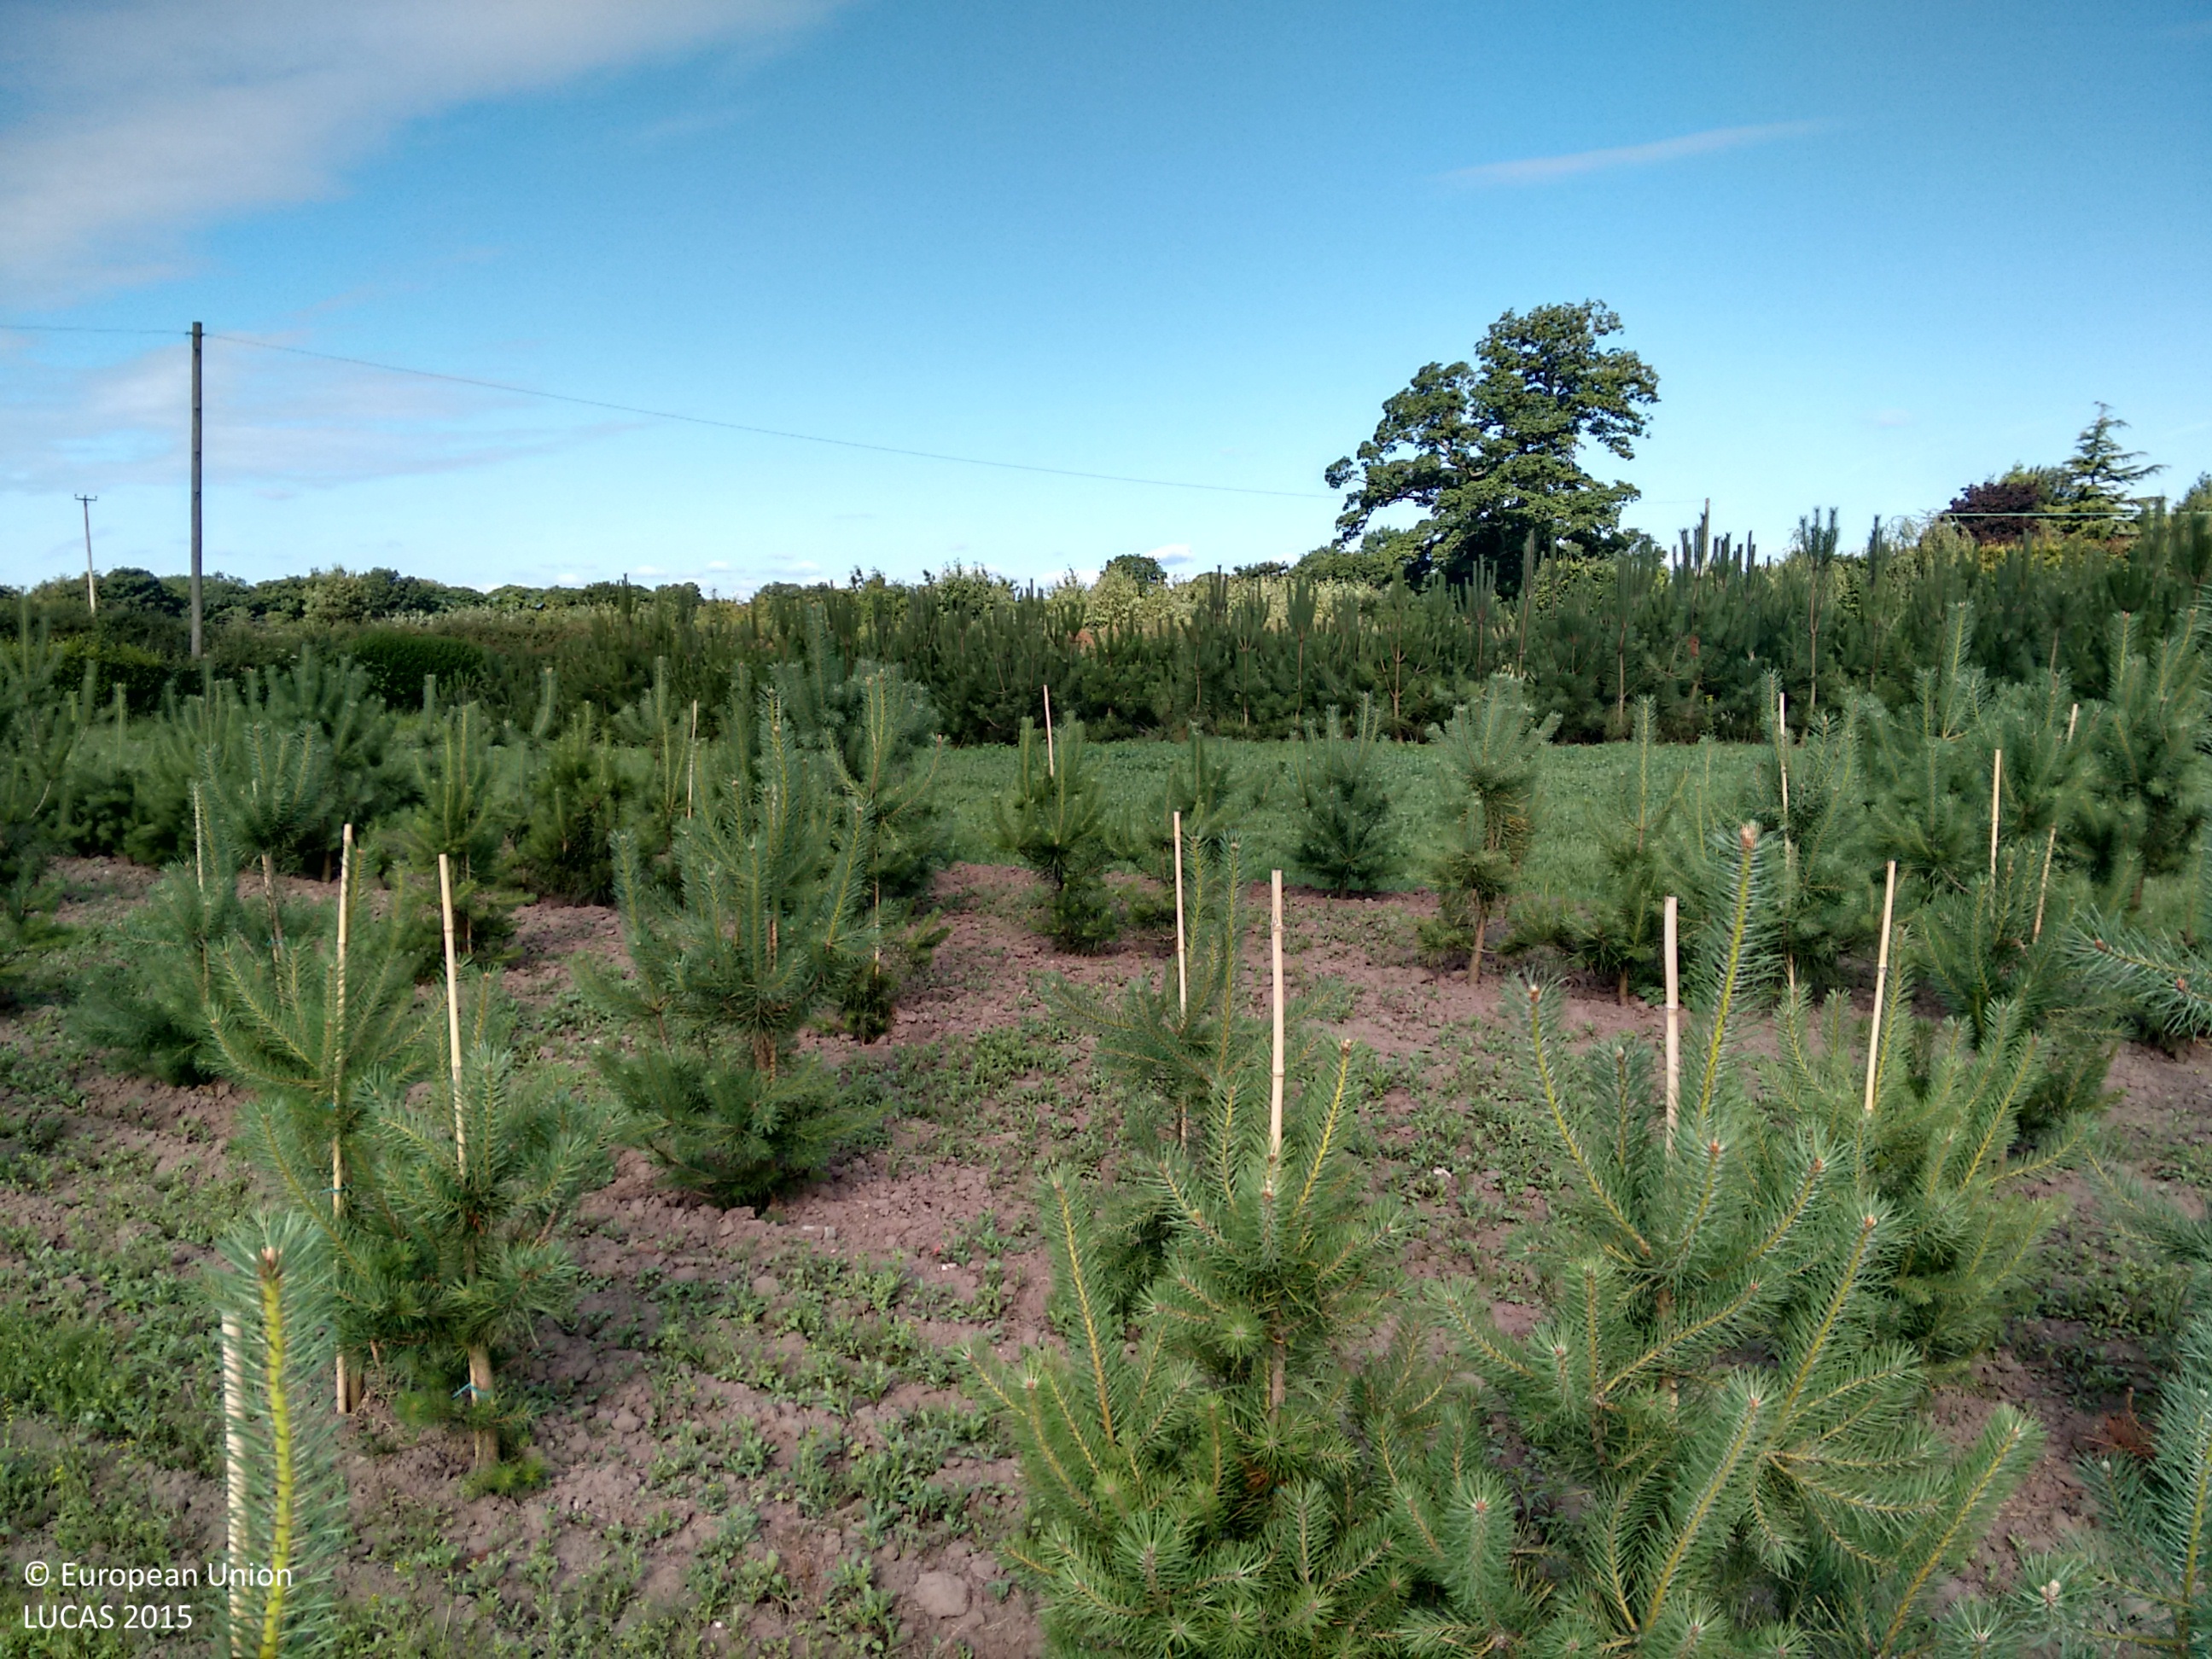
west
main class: Cropland
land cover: Nurseries
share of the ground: > 75 %
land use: Agriculture (excluding fallow land and kitchen gardens)
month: July
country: GB
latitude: 53.1177
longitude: -2.2995
